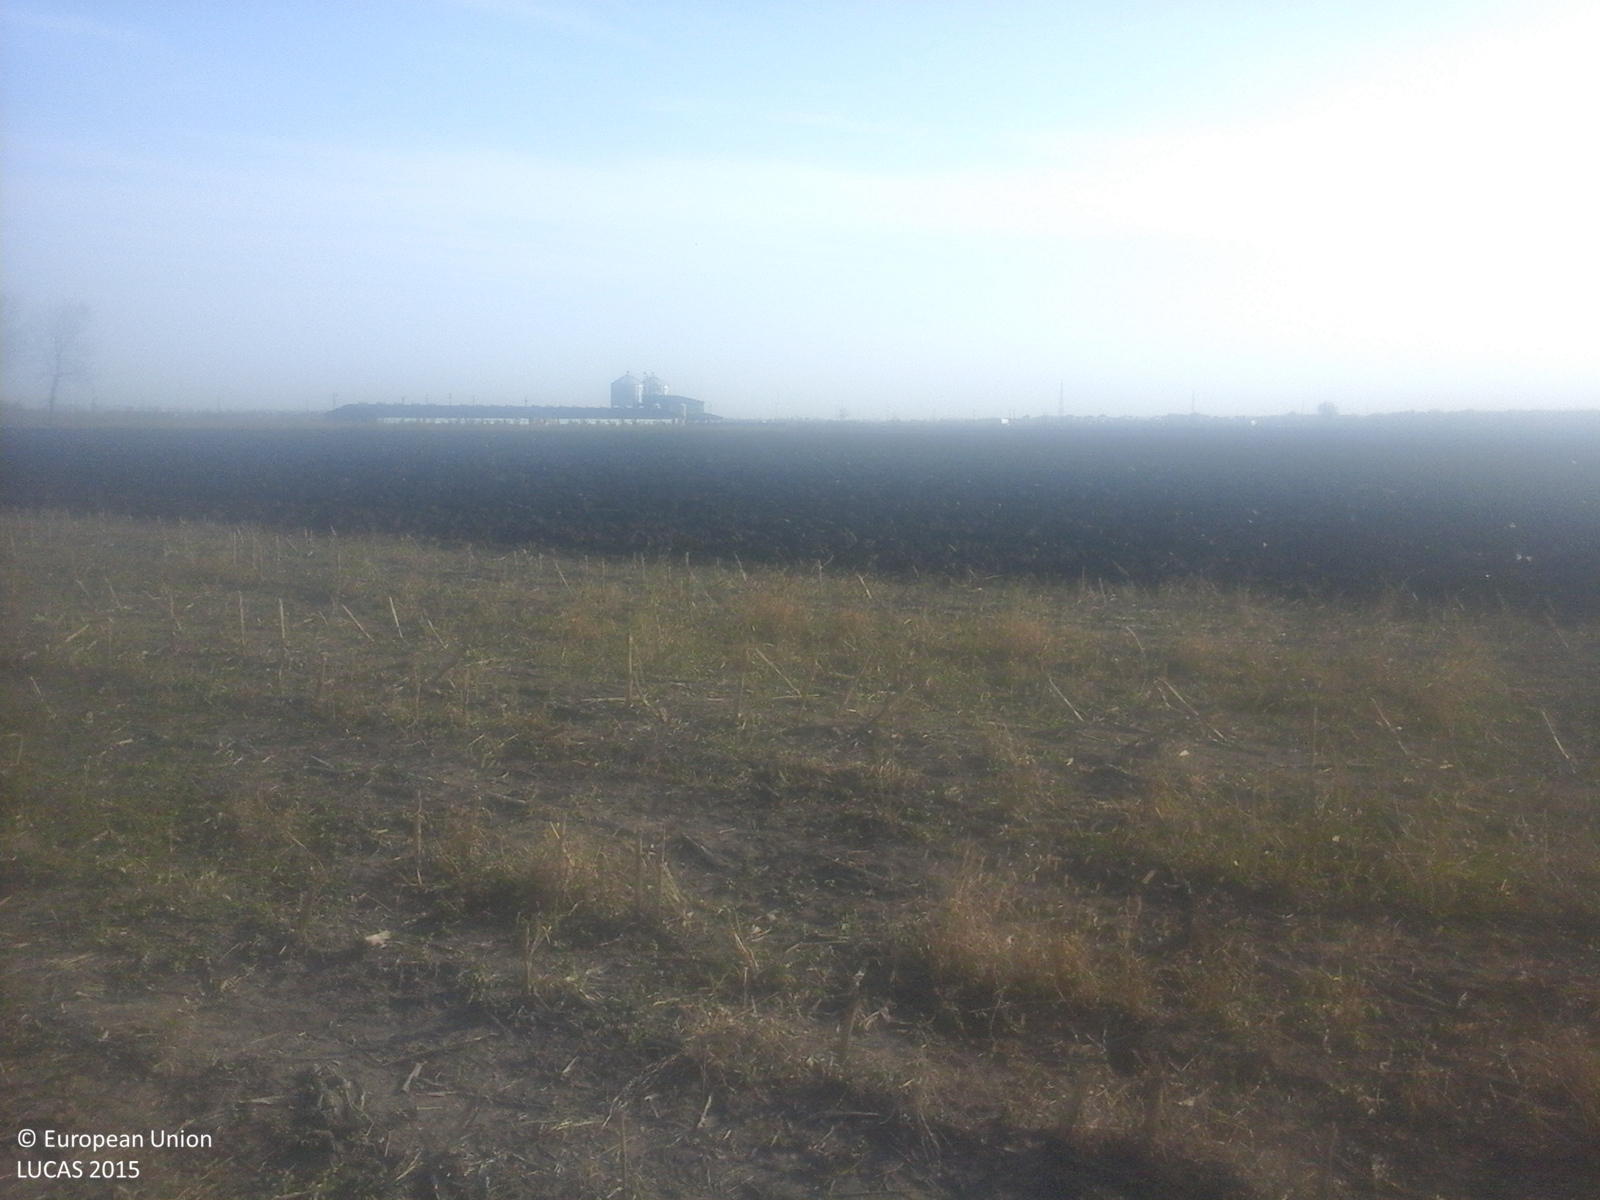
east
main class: Cropland
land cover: Maize
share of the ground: 10 - 25 %
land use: Agriculture (excluding fallow land and kitchen gardens)
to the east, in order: Maize; Other bare soil
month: October
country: RO
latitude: 45.3685
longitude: 27.0832
